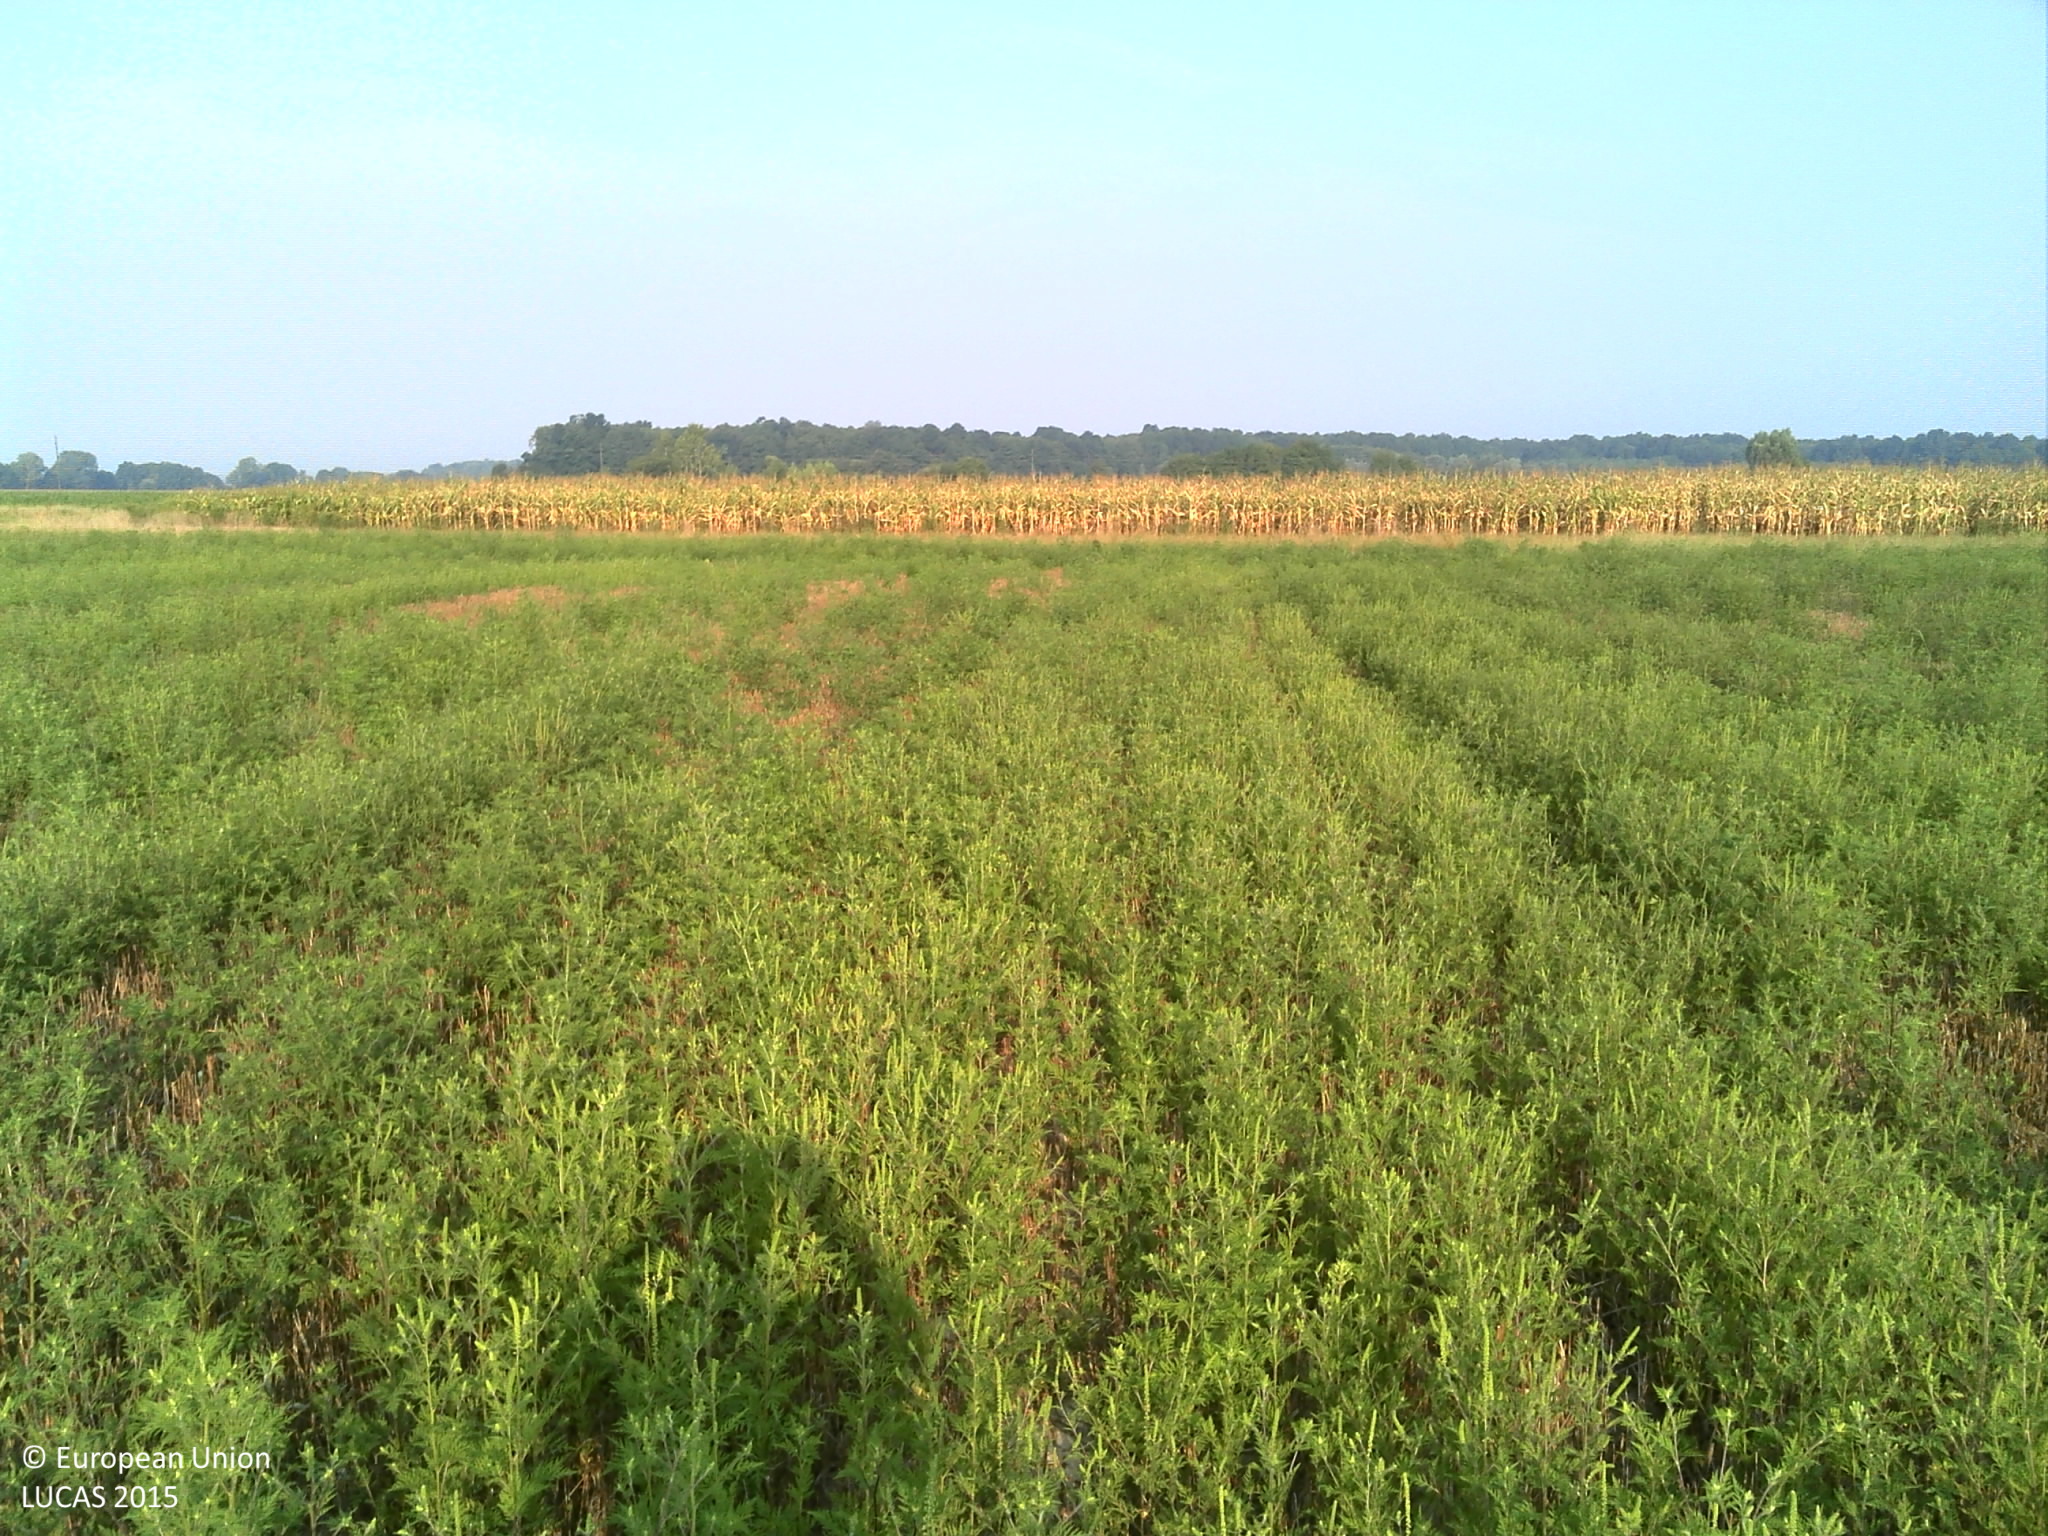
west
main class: Cropland
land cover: Common wheat
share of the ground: 10 - 25 %
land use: Agriculture (excluding fallow land and kitchen gardens)
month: August
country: HR
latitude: 45.9806
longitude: 17.2176
